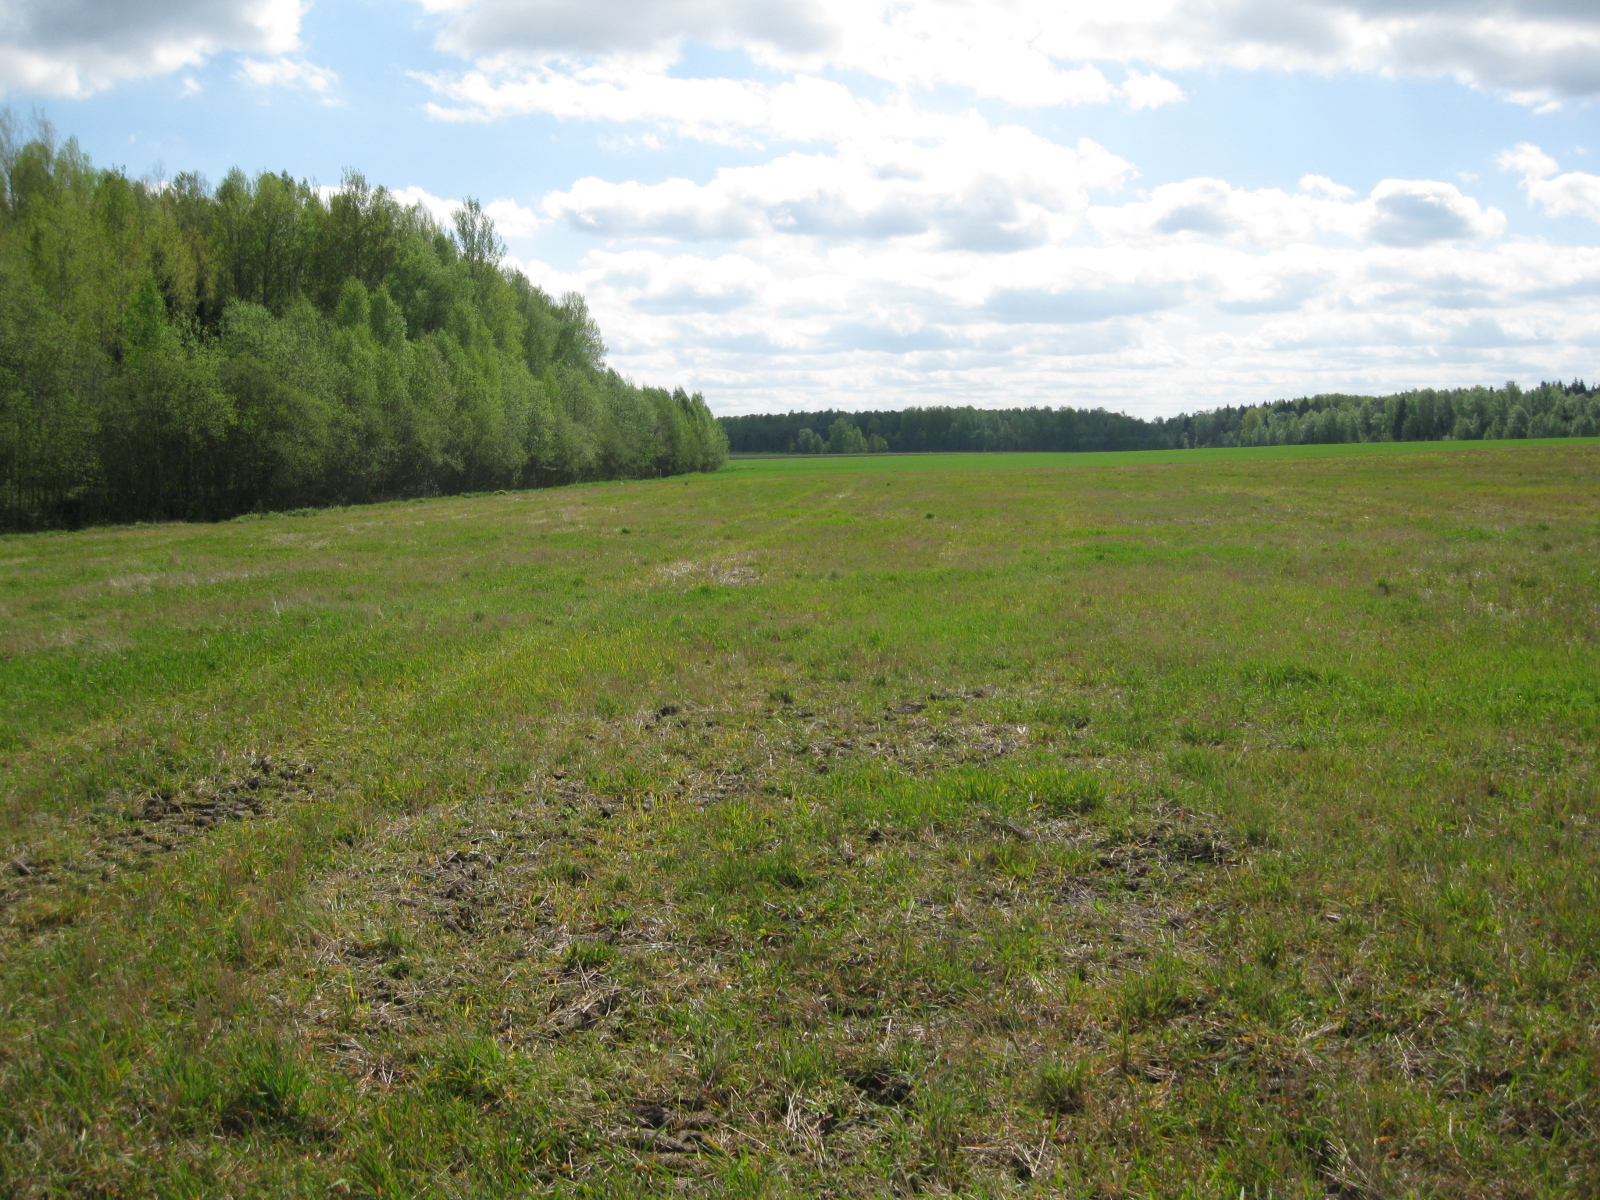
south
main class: Grassland
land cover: Spontaneously vegetated surfaces
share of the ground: > 75 %
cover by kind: herbaceous plants 85 %, unconsolidated bare surface 15 %
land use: Fallow land
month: May
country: LT
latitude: 56.2023
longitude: 24.9536
